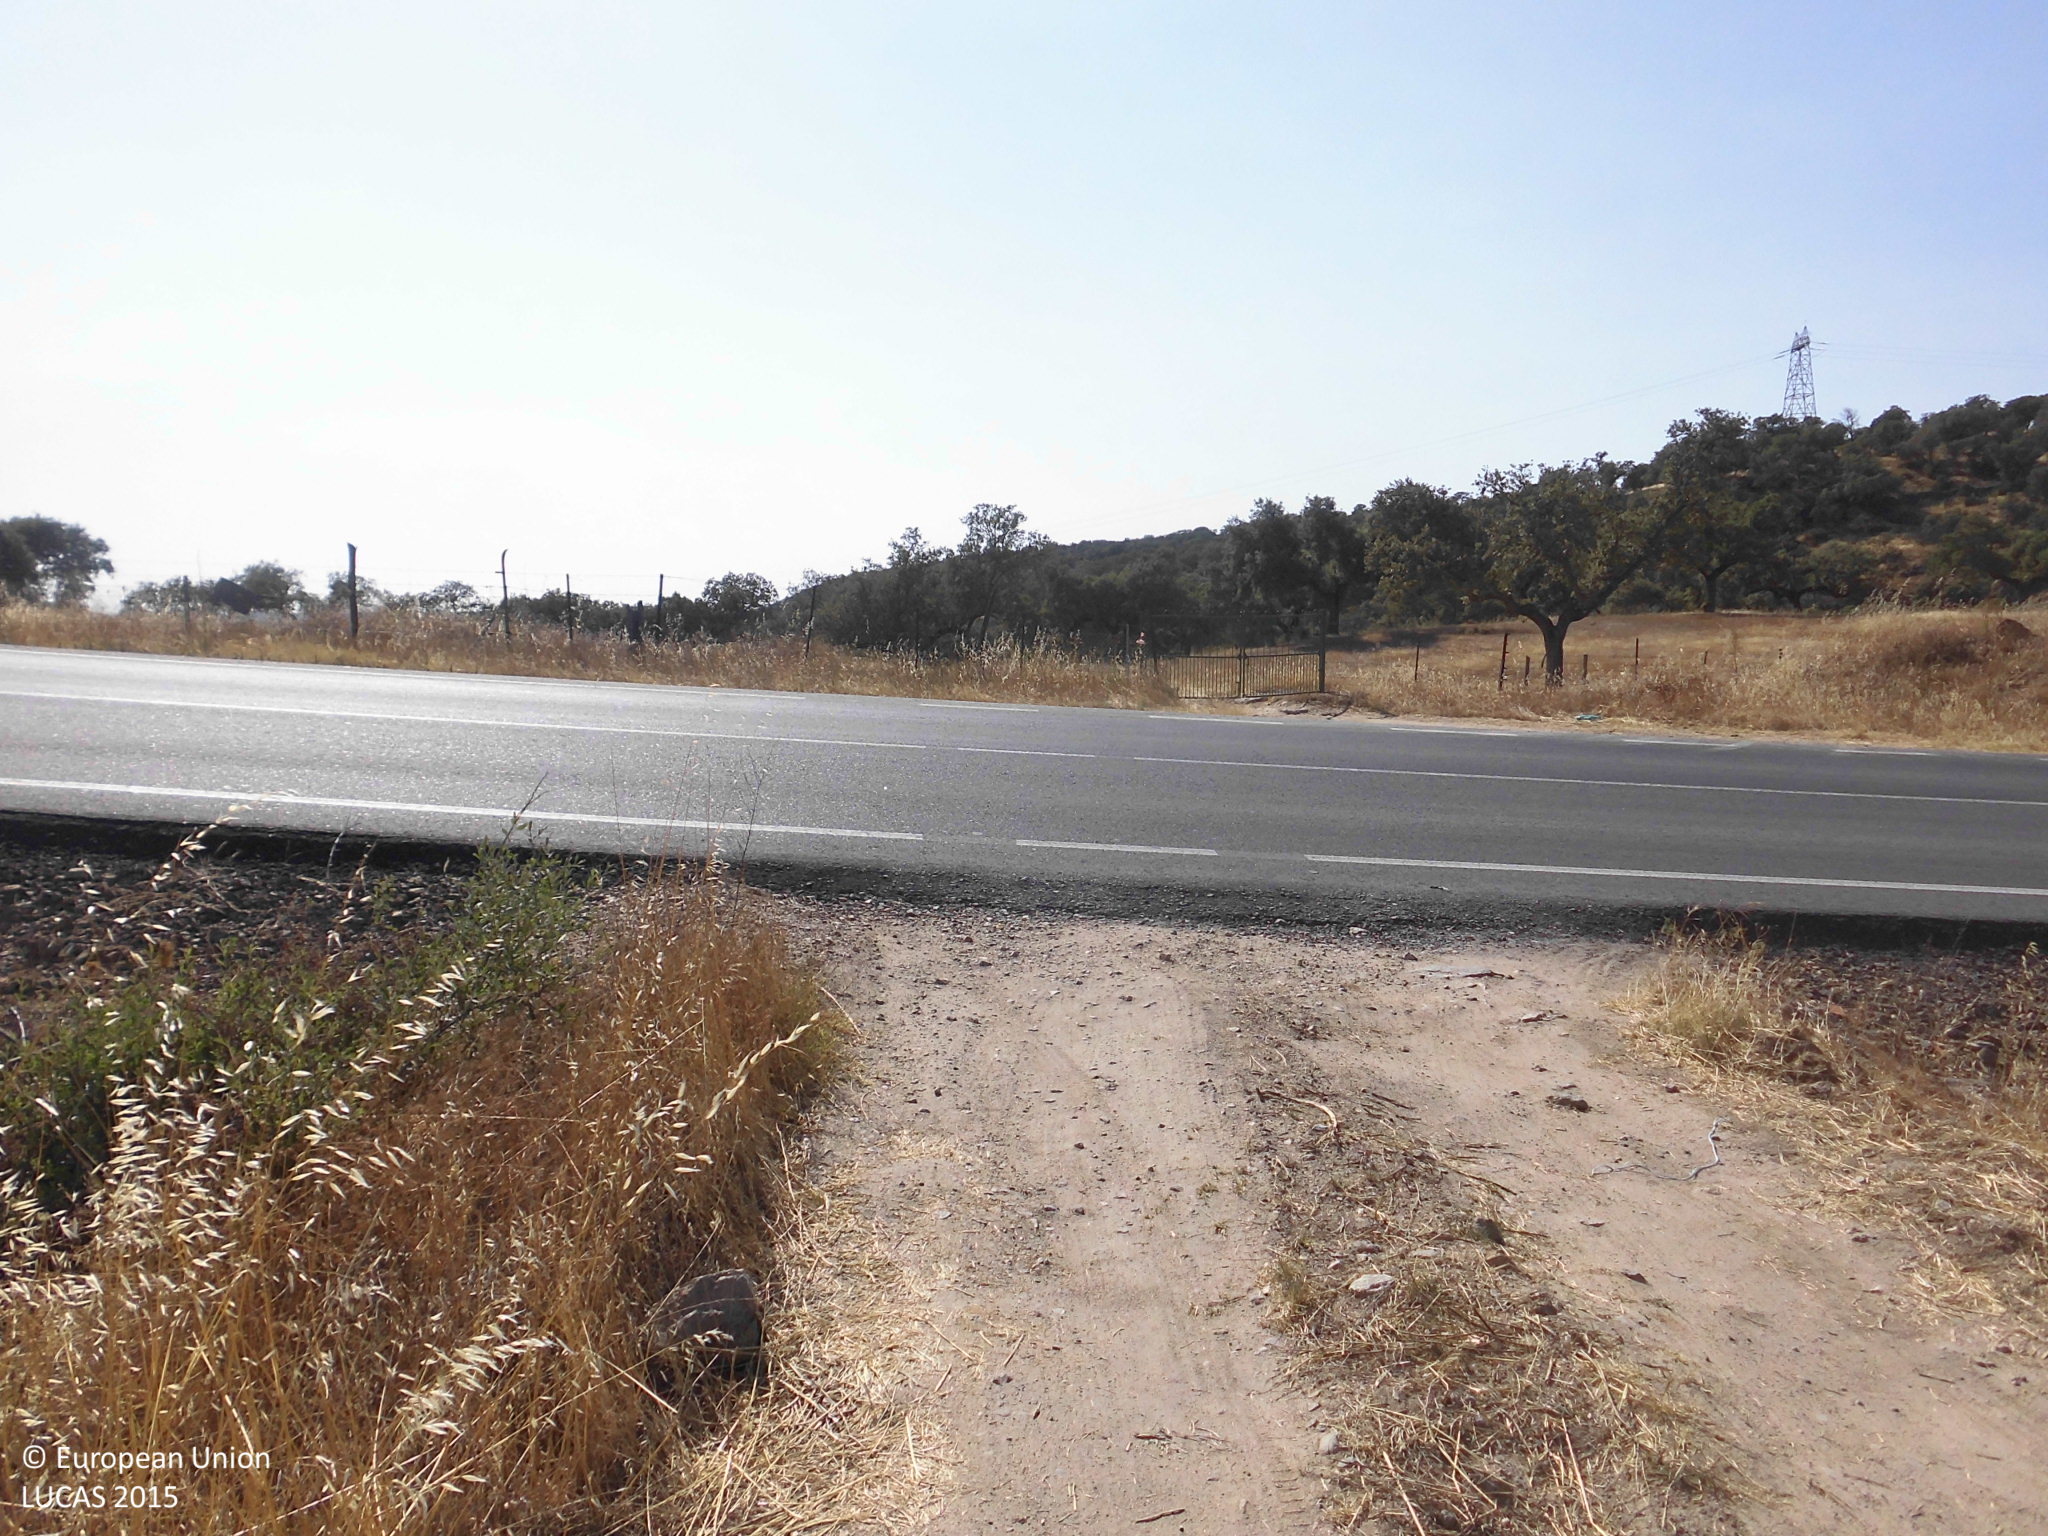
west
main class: Woodland
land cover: Broadleaved woodland
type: broadleaved evergreen forest
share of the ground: 25 - 50 %
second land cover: Grassland without tree/shrub cover
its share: > 75 %
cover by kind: herbaceous plants 55 %, broadleaved forest trees 45 %
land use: Forestry
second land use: Agriculture (excluding fallow land and kitchen gardens)
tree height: > 5 m
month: July
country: ES
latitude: 40.0903
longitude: -6.0820
